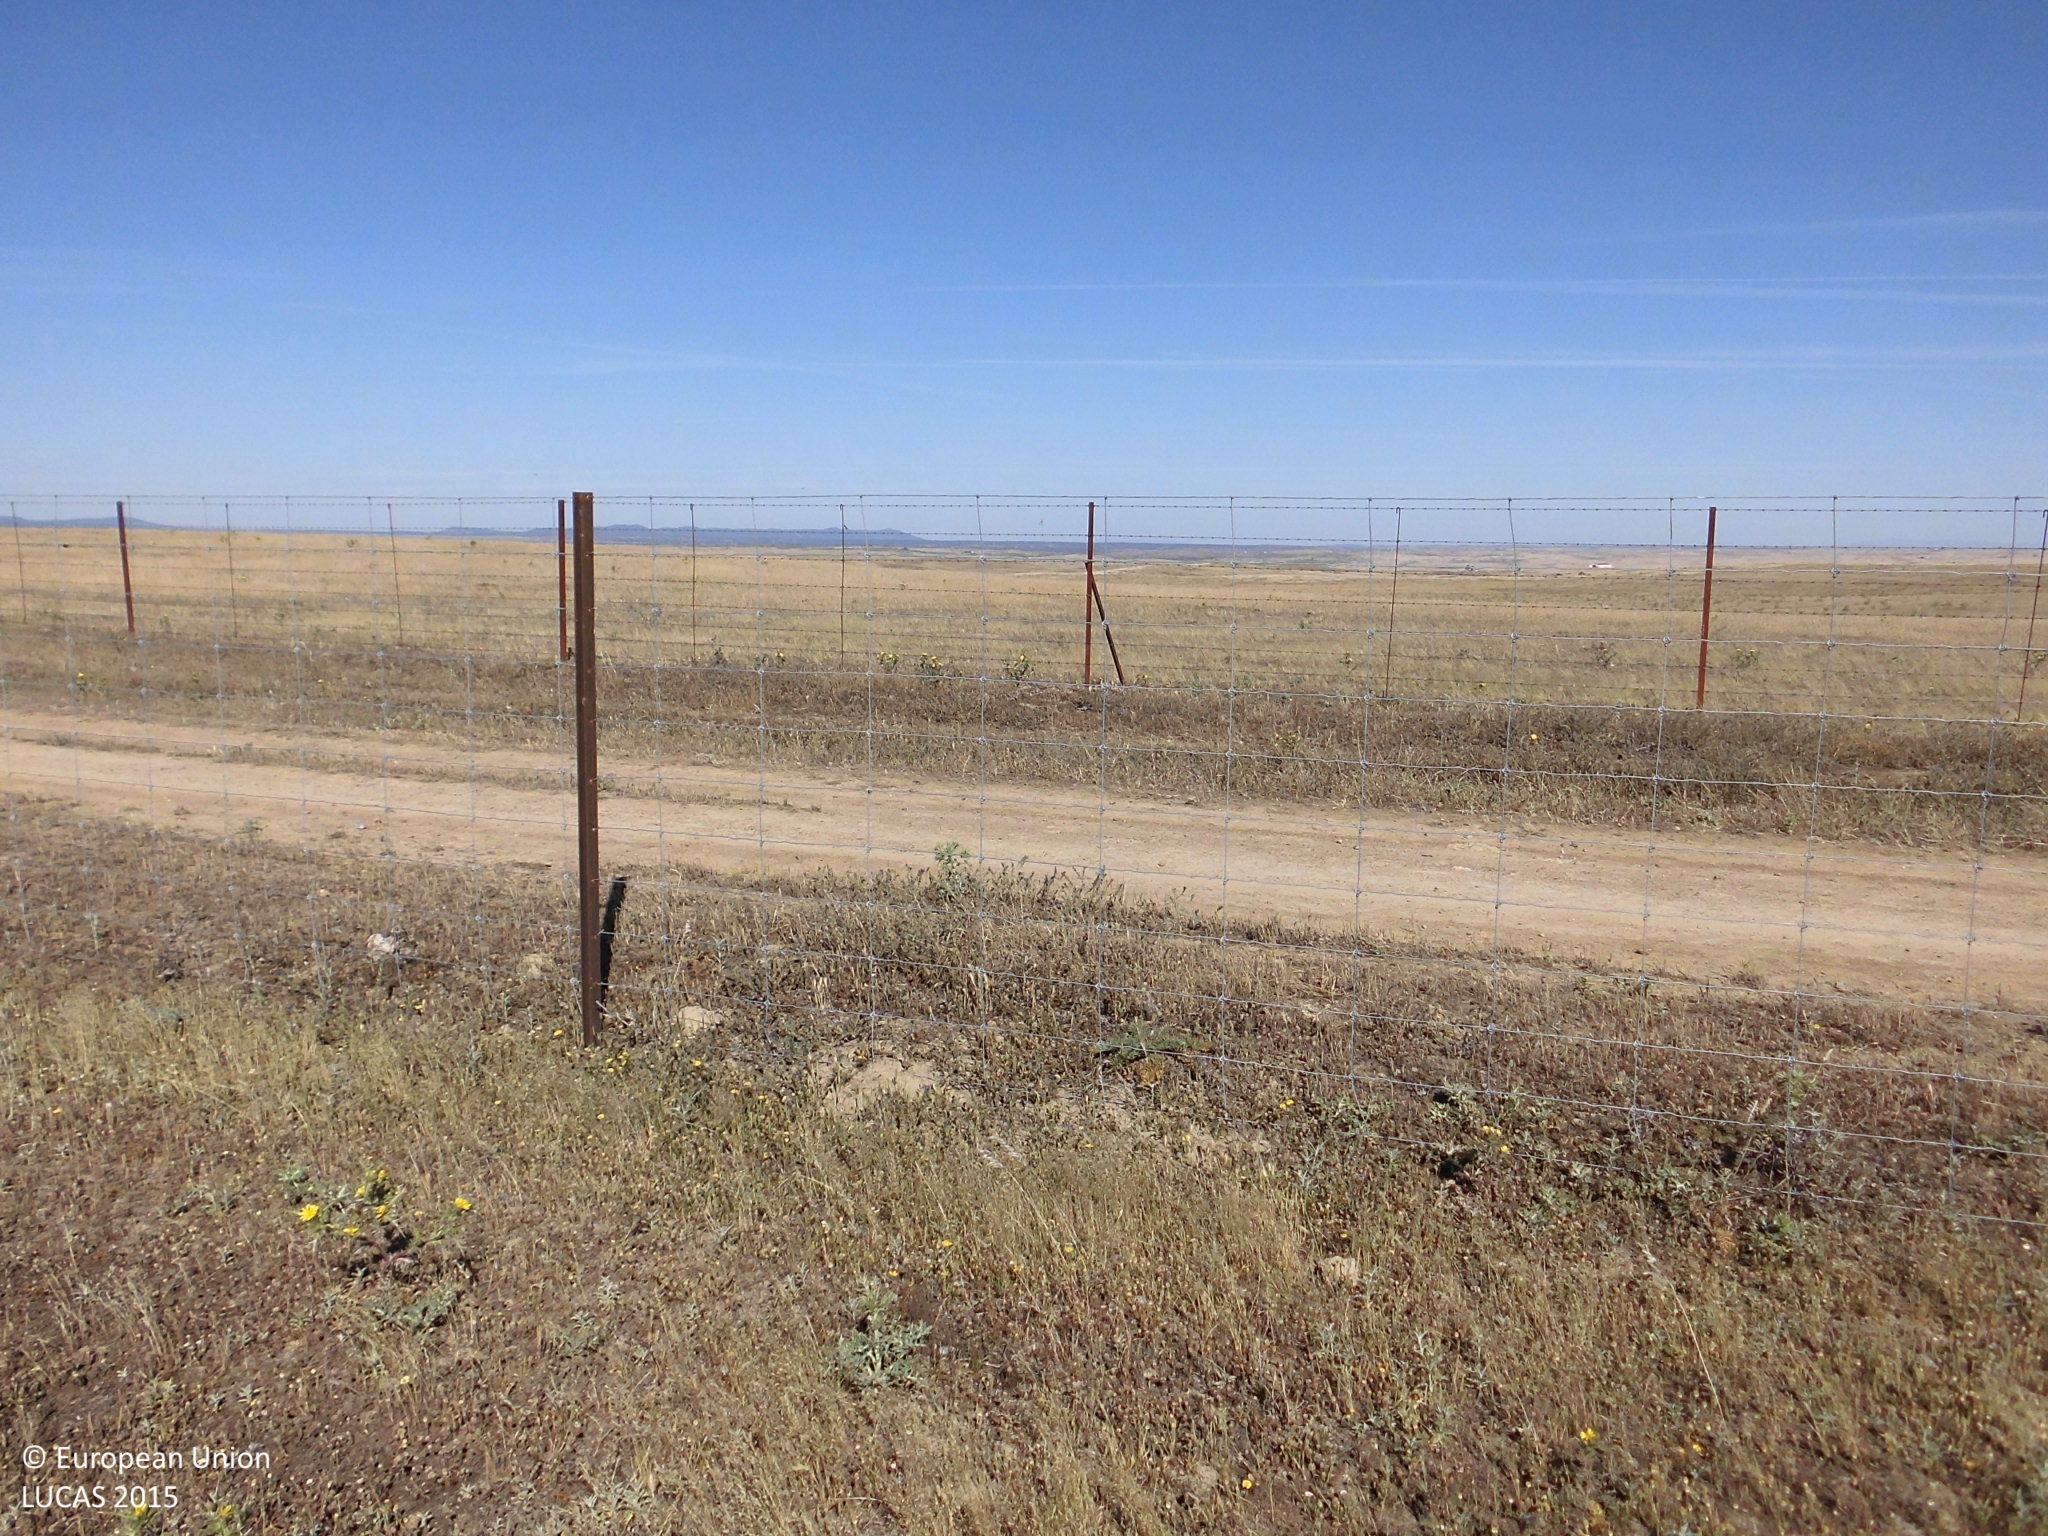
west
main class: Grassland
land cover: Grassland without tree/shrub cover
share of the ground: > 75 %
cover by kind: herbaceous plants 100 %
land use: Agriculture (excluding fallow land and kitchen gardens)
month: May
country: ES
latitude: 39.5364
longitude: -6.8450
